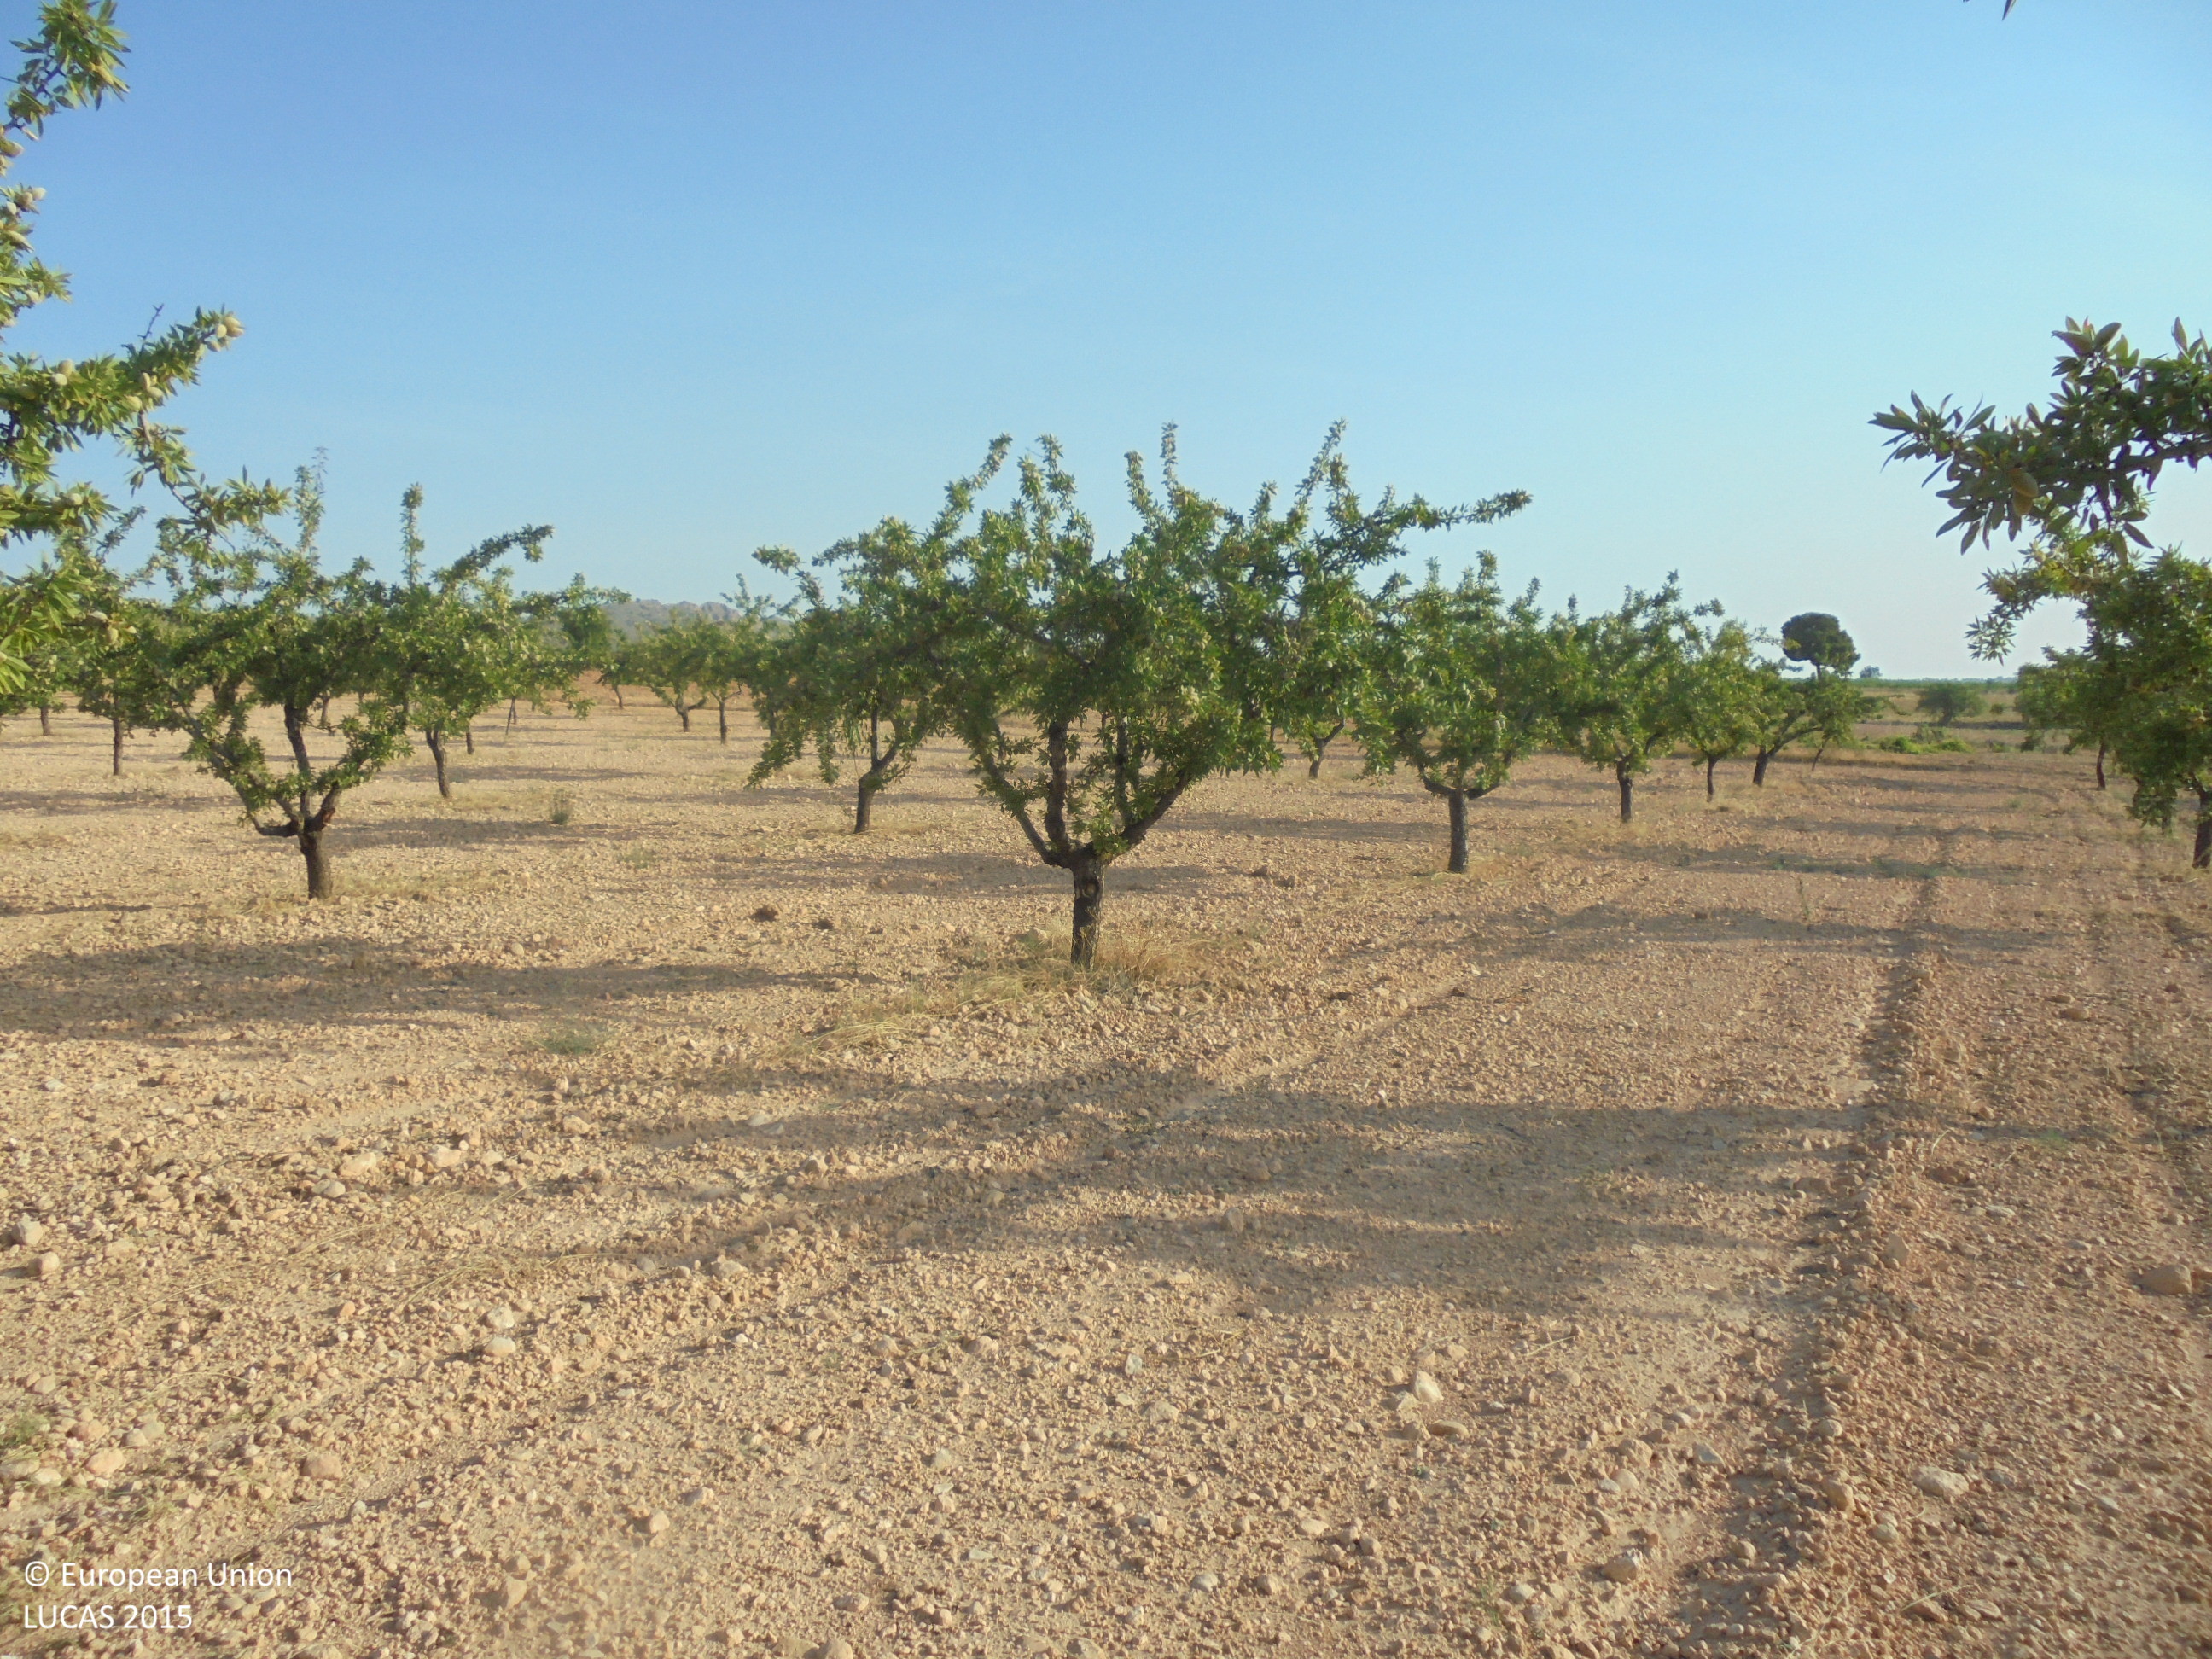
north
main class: Cropland
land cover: Nuts trees
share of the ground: 25 - 50 %
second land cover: Other bare soil
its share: > 75 %
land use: Agriculture (excluding fallow land and kitchen gardens)
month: July
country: ES
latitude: 38.6231
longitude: -1.6296
